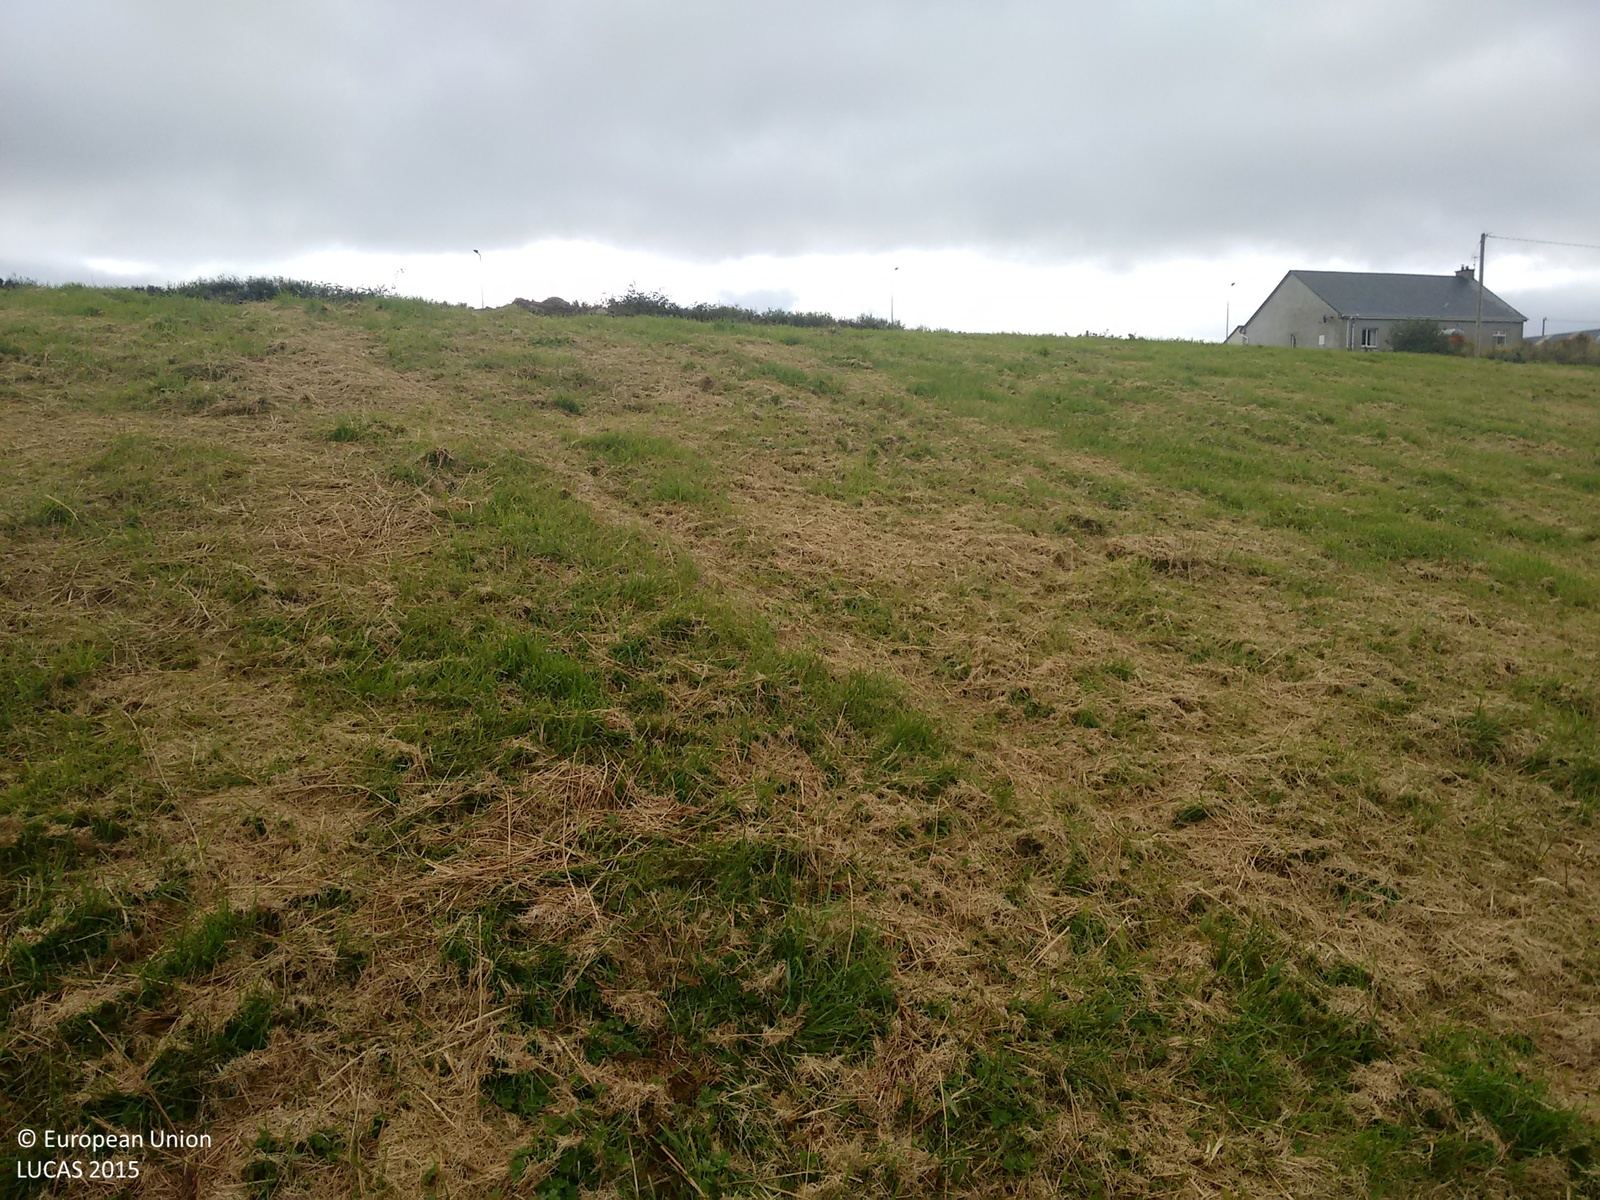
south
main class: Grassland
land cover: Grassland without tree/shrub cover
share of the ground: > 75 %
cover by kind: herbaceous plants 100 %
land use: Agriculture (excluding fallow land and kitchen gardens)
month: September
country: IE
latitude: 52.1449
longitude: -10.1491
